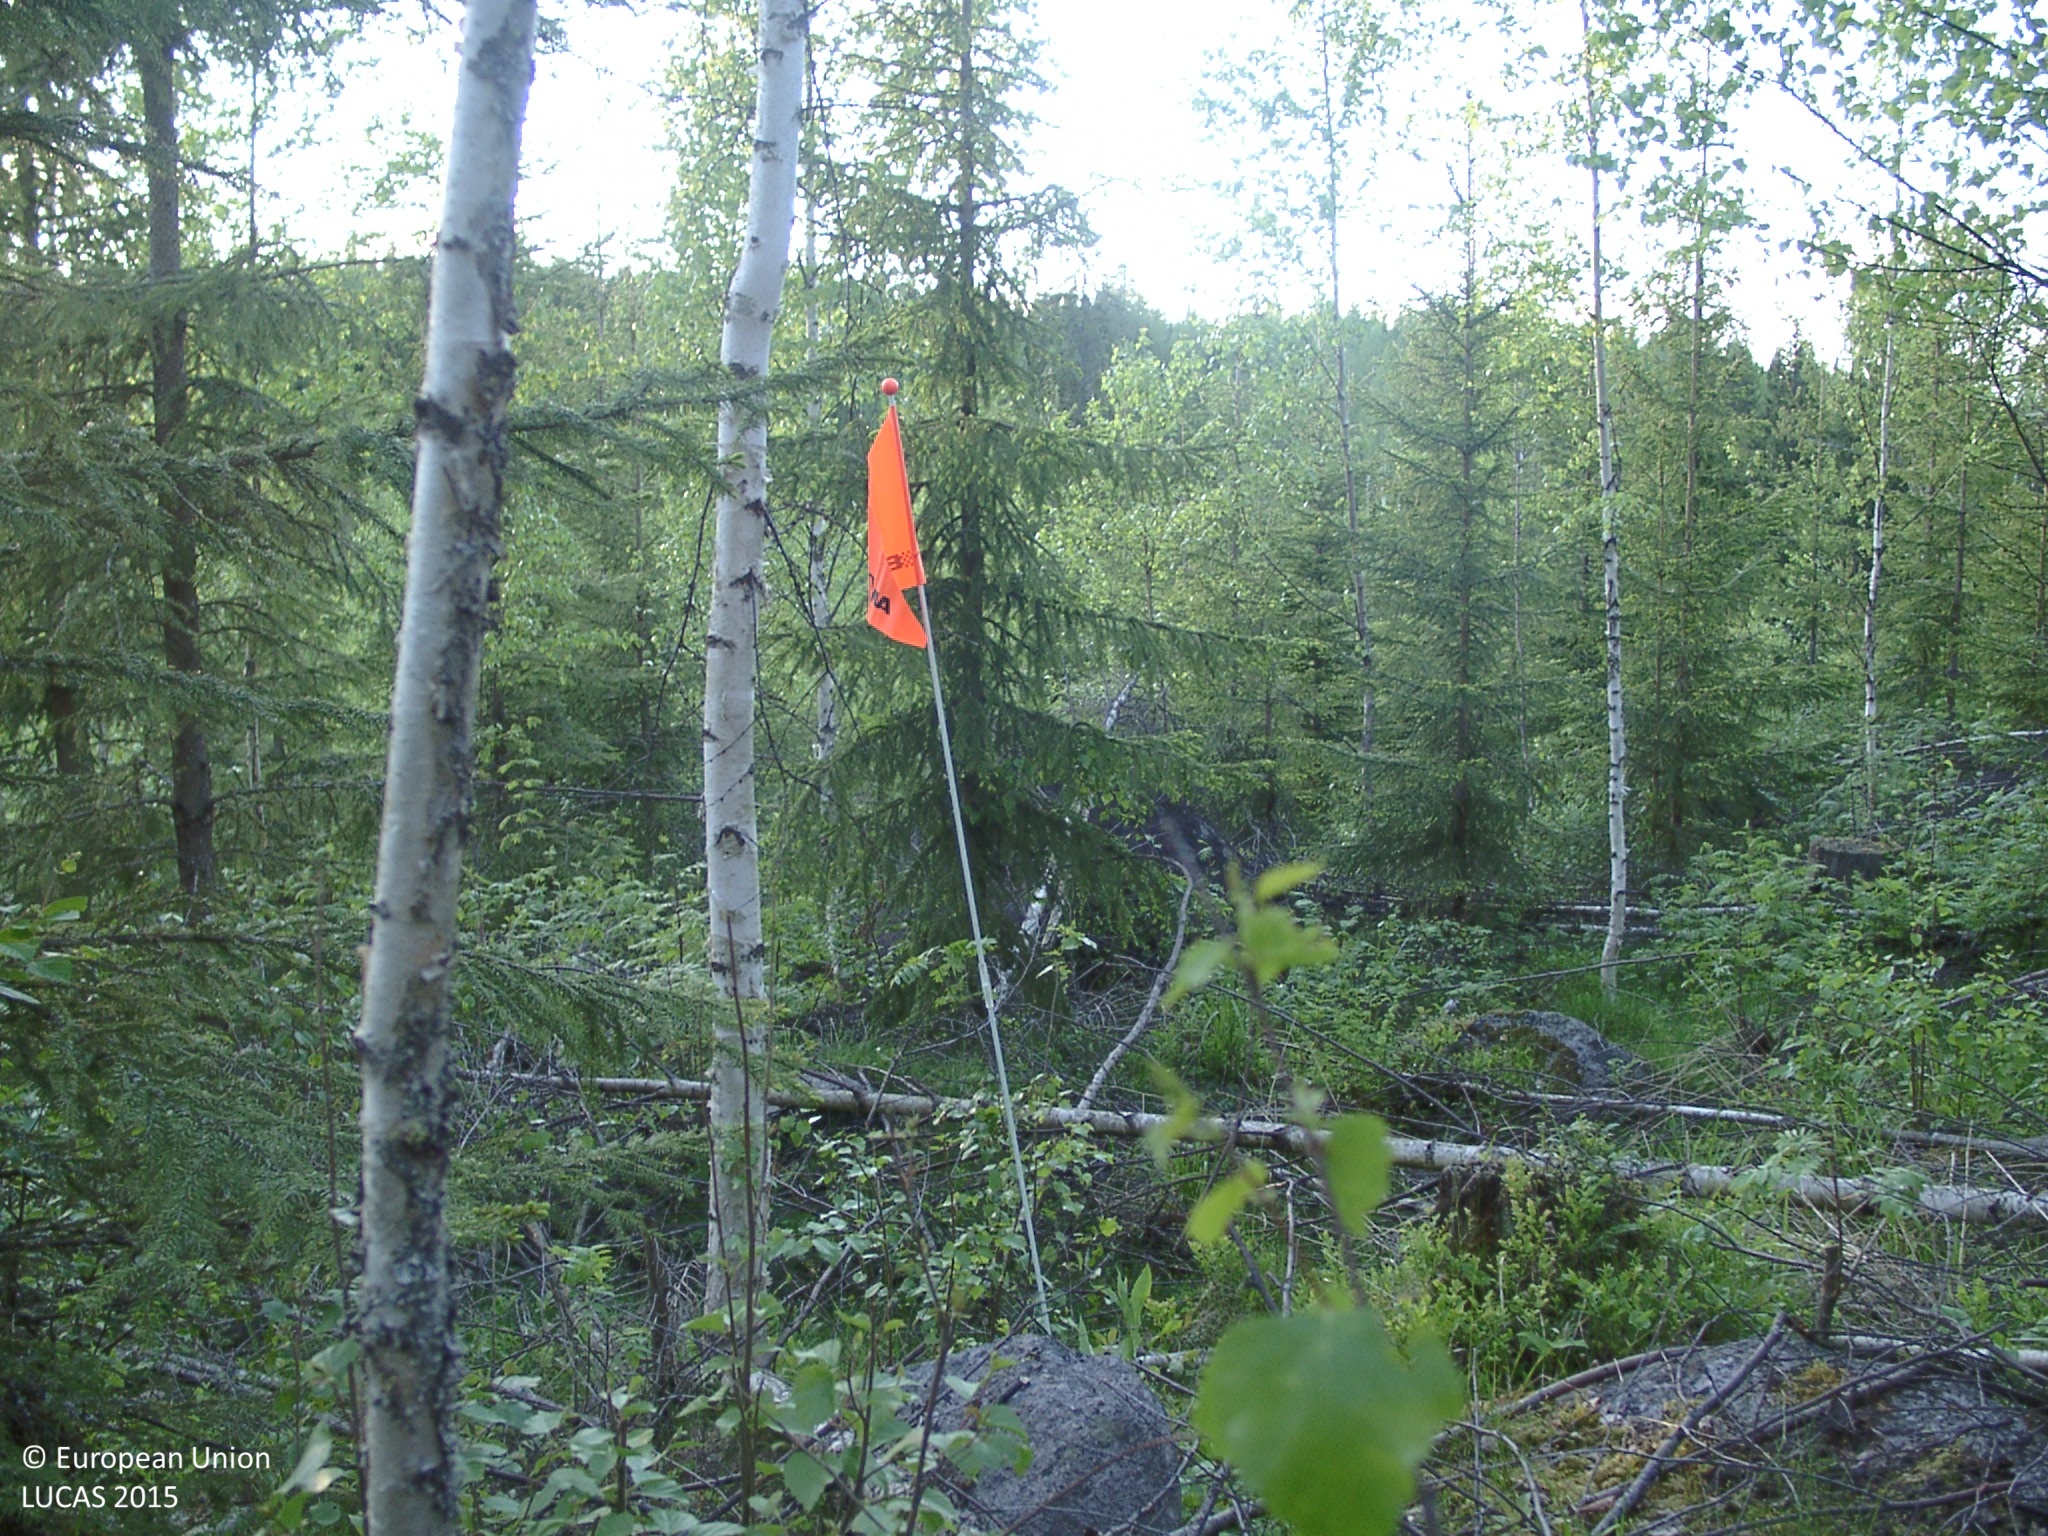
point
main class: Woodland
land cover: Spruce dominated mixed woodland
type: boreal forest
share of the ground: 50 - 75 %
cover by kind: broadleaved forest trees 35 %, coniferous forest trees 25 %, herbaceous plants 20 %, shrubs 5 %, lichens and mosses 5 %
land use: Forestry
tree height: < 5 m
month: June
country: FI
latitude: 62.1773
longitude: 25.6165
